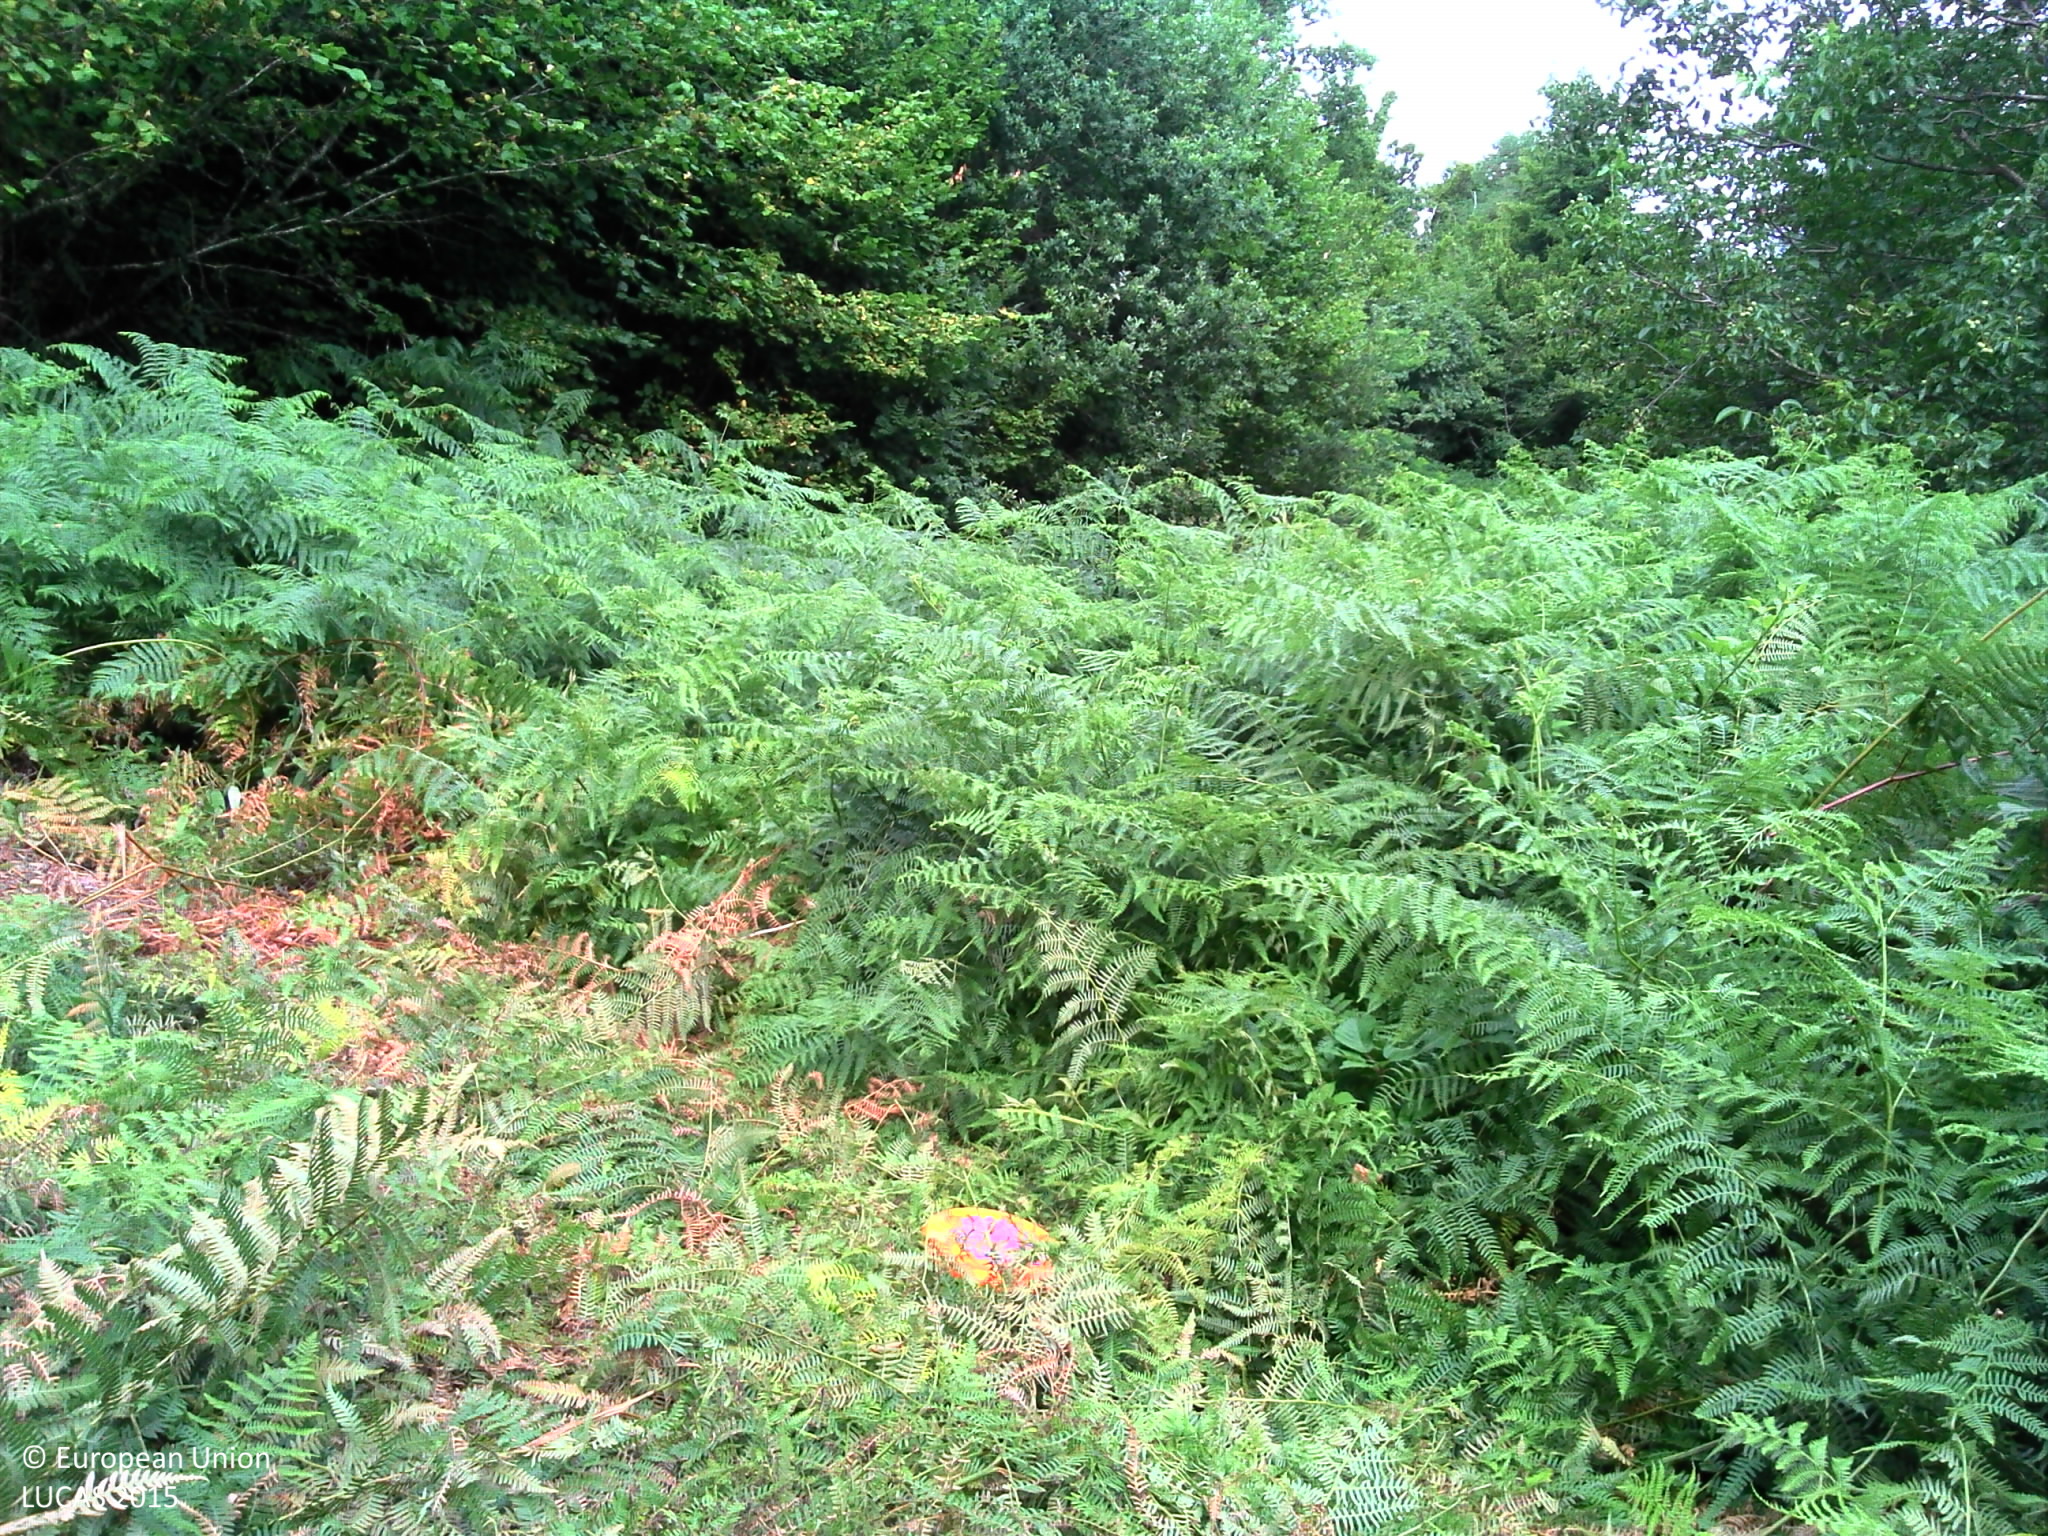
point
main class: Grassland
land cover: Spontaneously vegetated surfaces
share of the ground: > 75 %
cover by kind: herbaceous plants 95 %
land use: Forestry
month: July
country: FR
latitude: 45.7639
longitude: 1.3382
